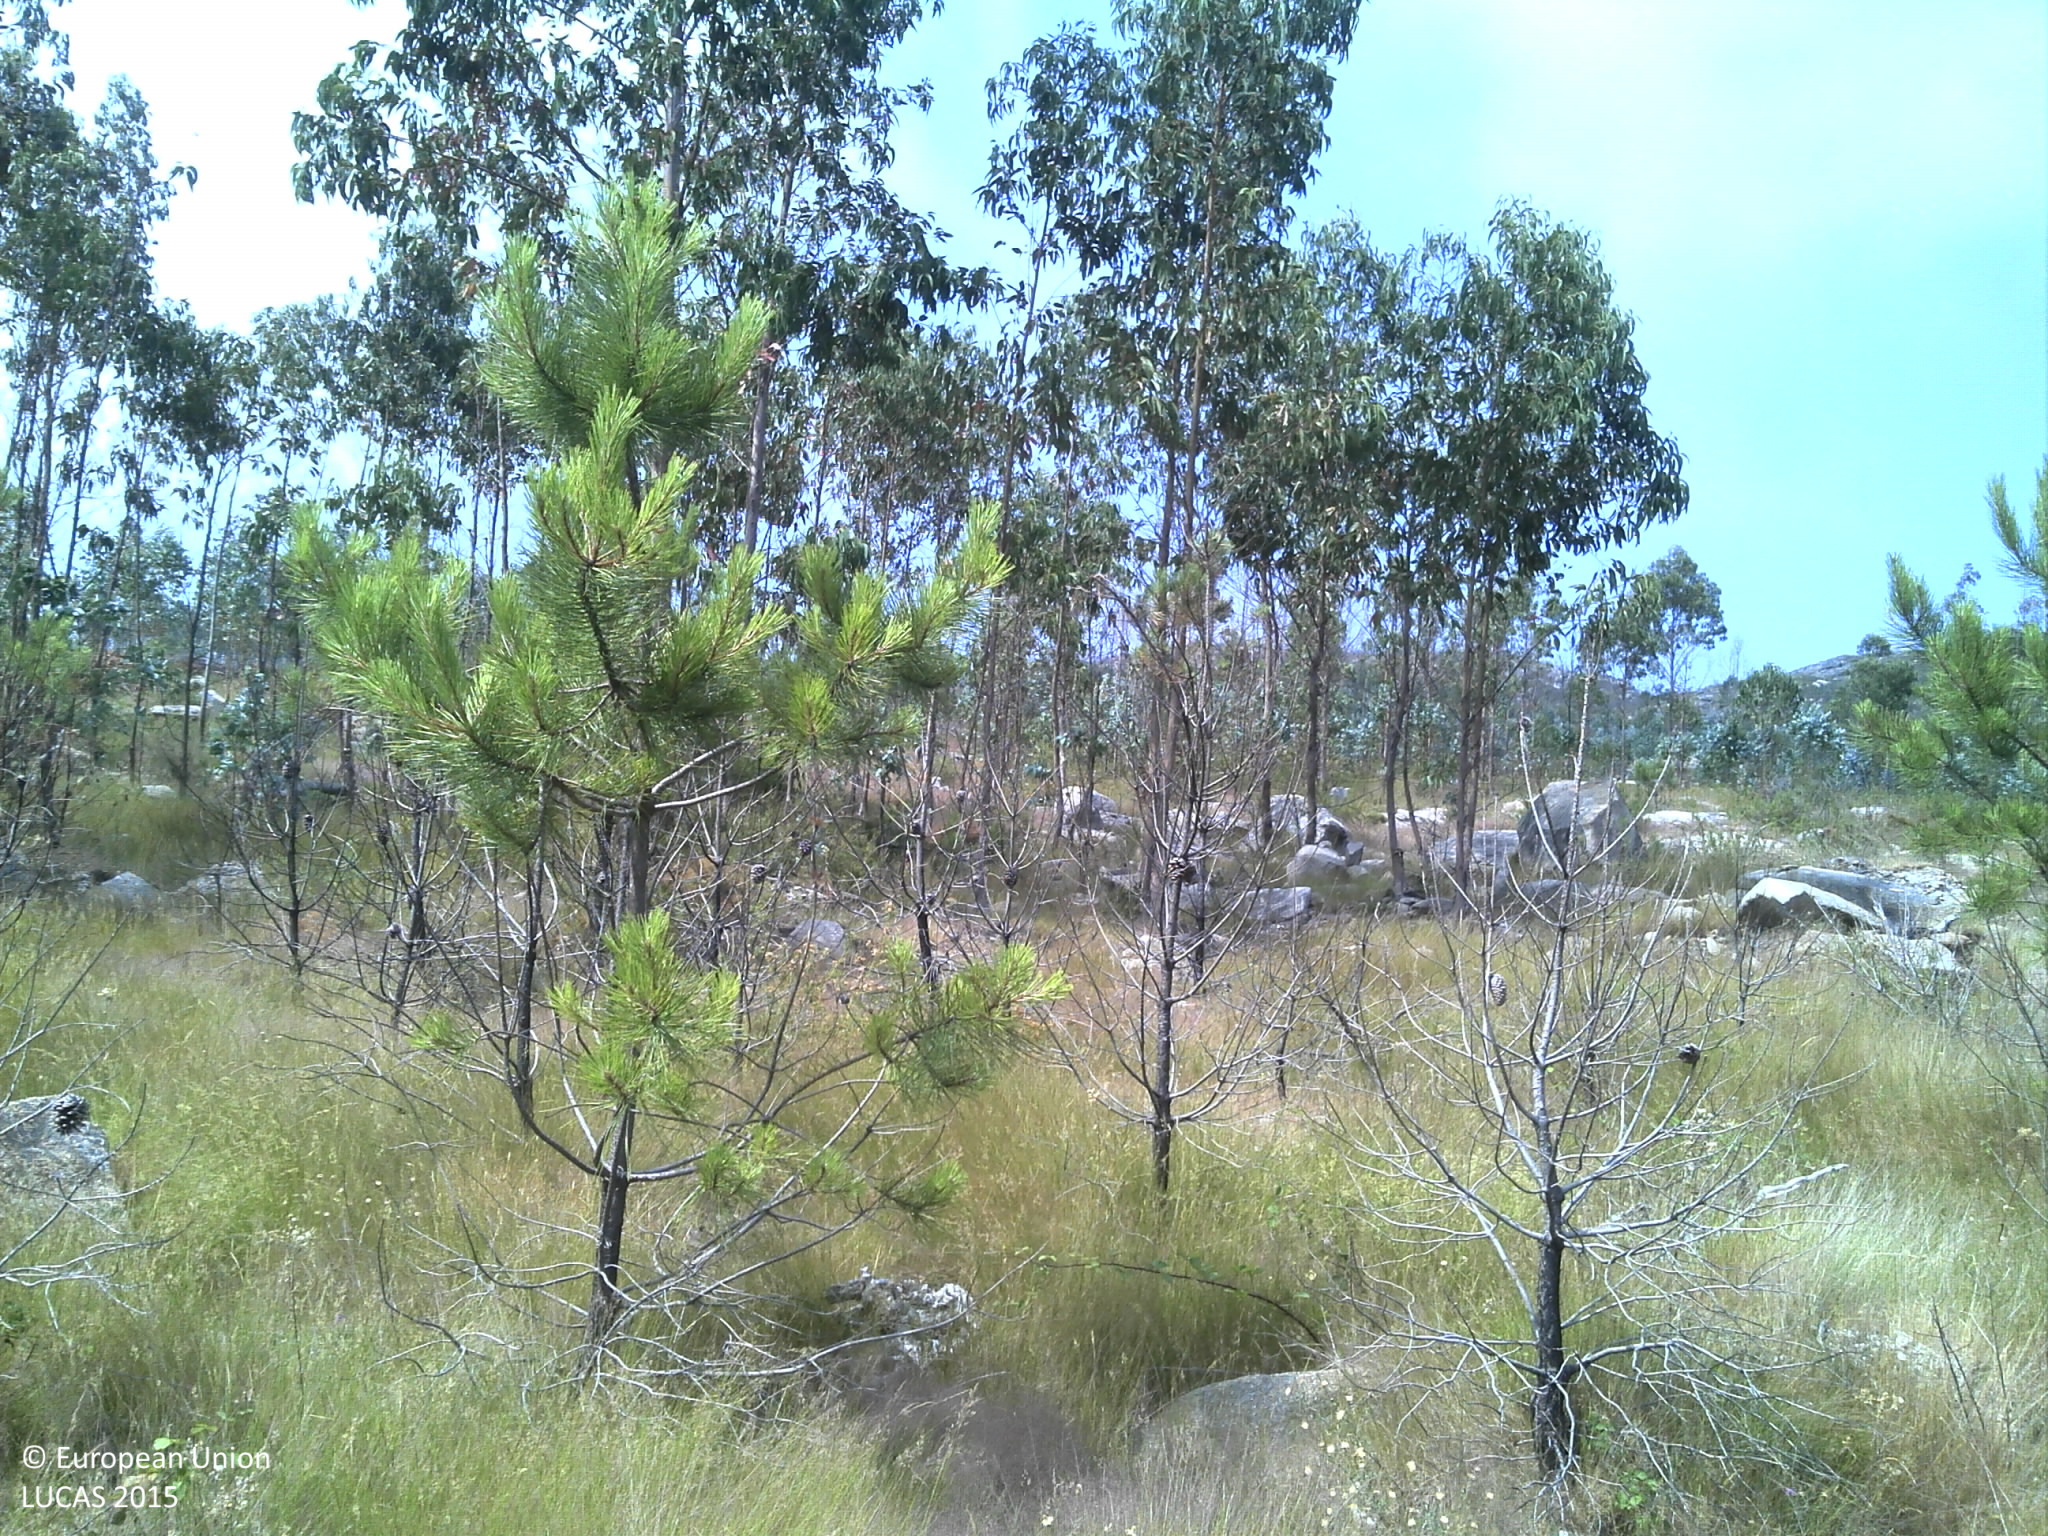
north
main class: Cropland
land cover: Maize
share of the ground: < 10 %
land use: Agriculture (excluding fallow land and kitchen gardens)
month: June
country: PT
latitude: 40.6926
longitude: -8.3003
